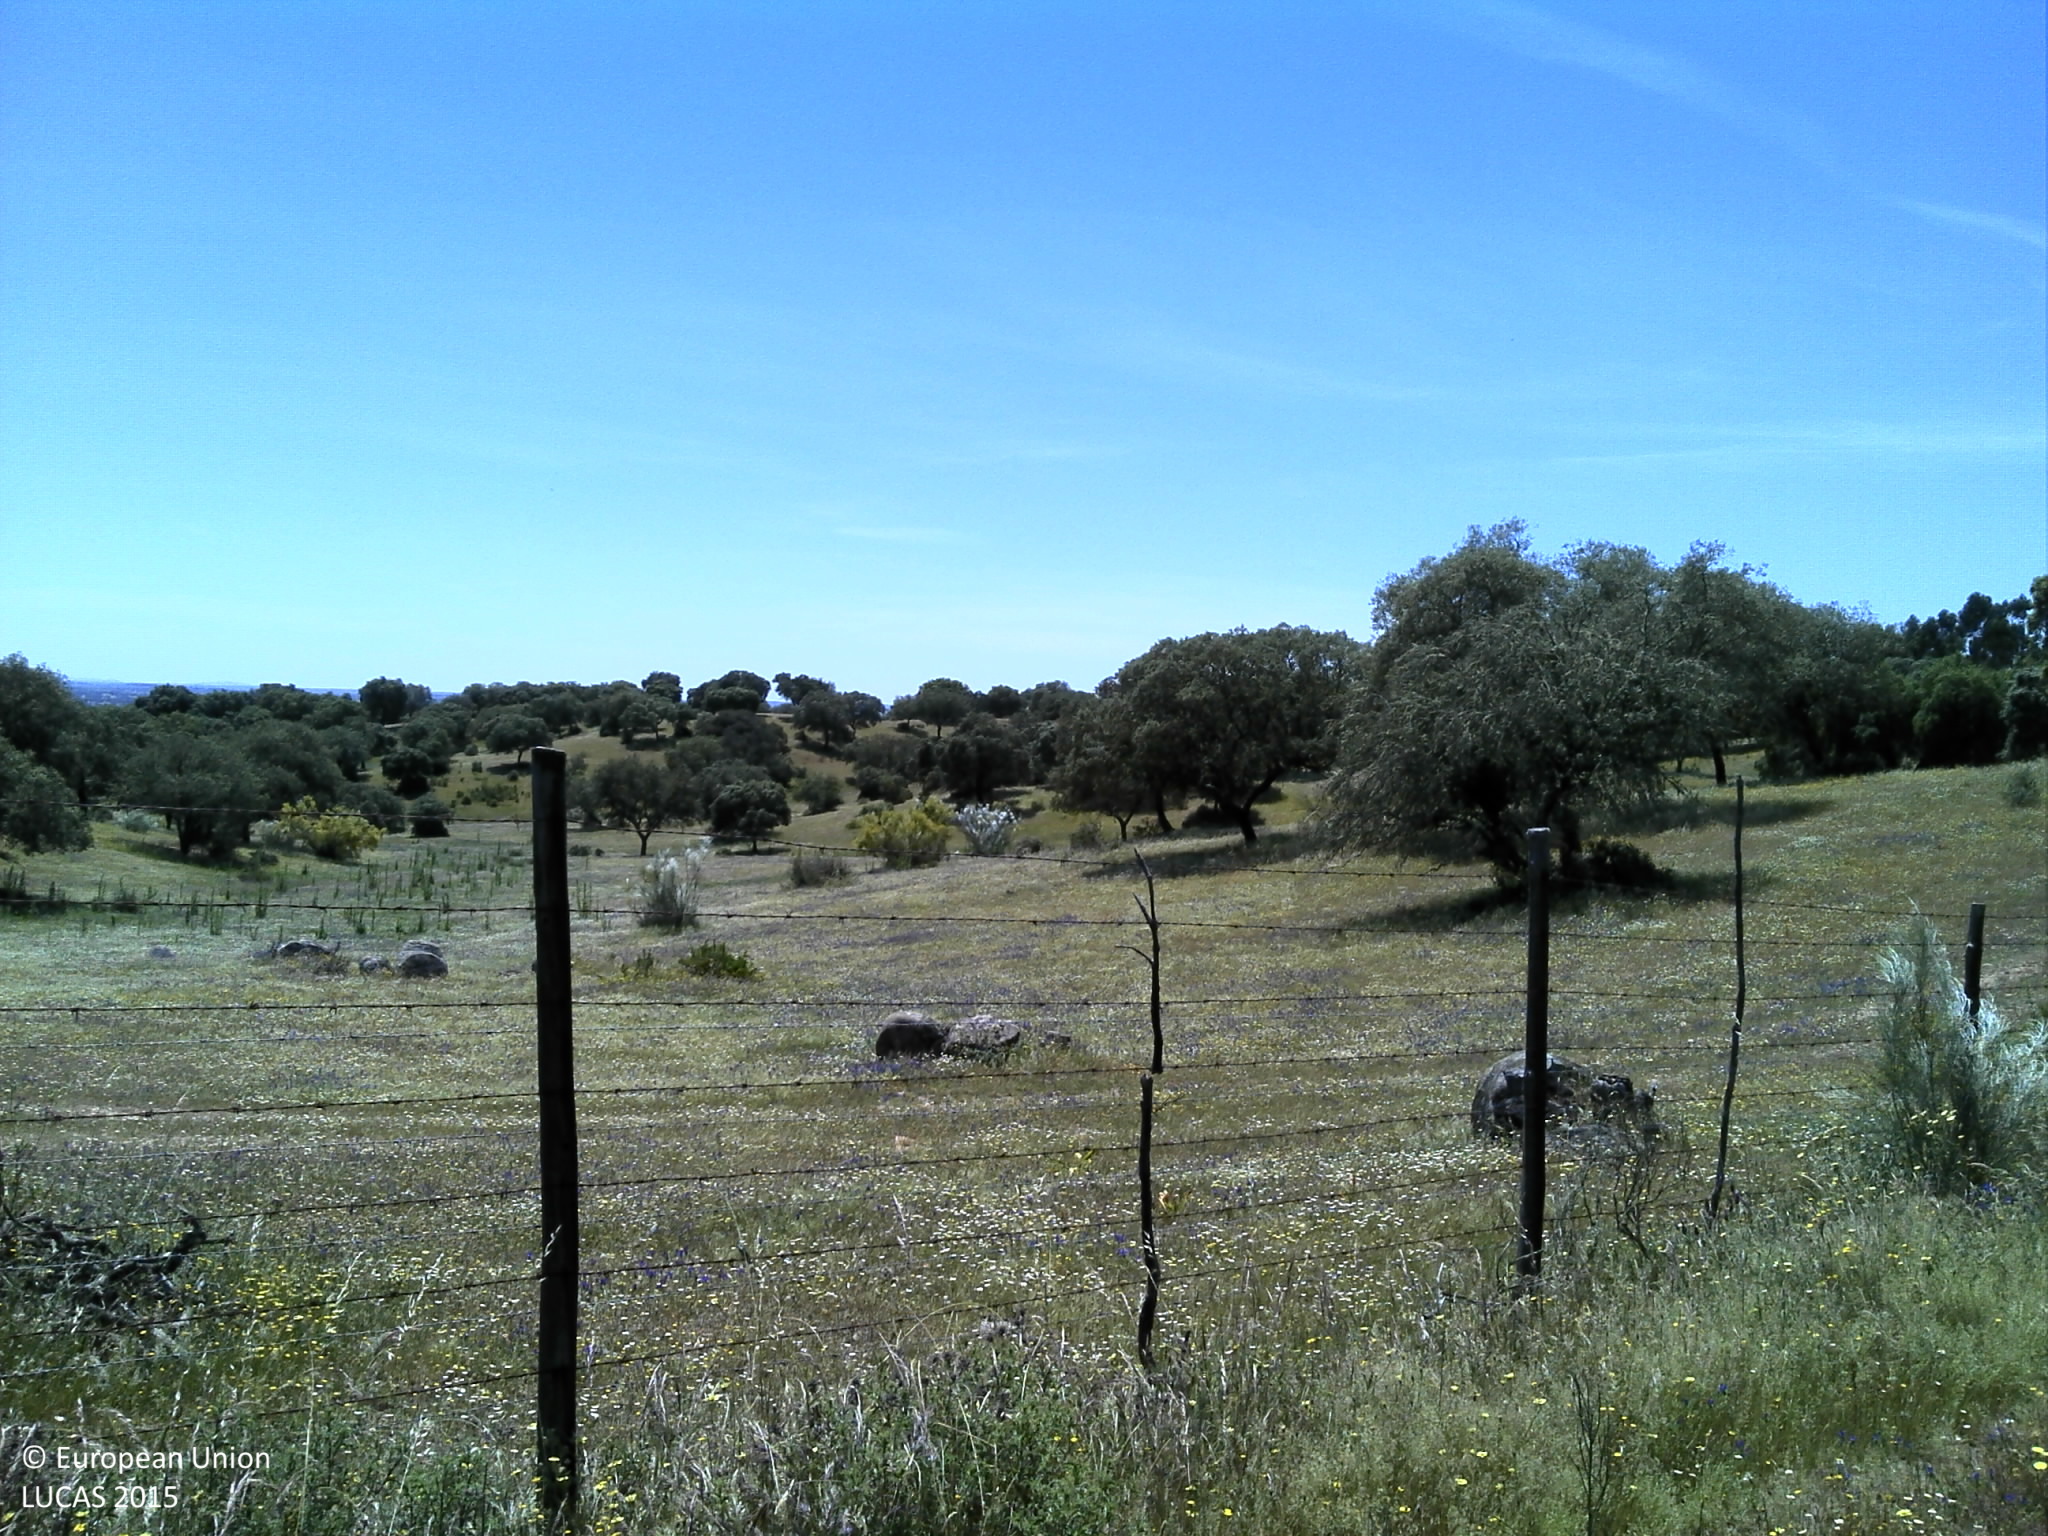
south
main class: Woodland
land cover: Broadleaved woodland
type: broadleaved evergreen forest
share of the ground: 10 - 25 %
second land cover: Grassland without tree/shrub cover
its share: 25 - 50 %
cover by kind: broadleaved forest trees 25 %, shrubs 25 %, herbaceous plants 25 %, unconsolidated bare surface 25 %
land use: Forestry
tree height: > 5 m
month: May
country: PT
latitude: 39.2068
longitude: -7.8492
